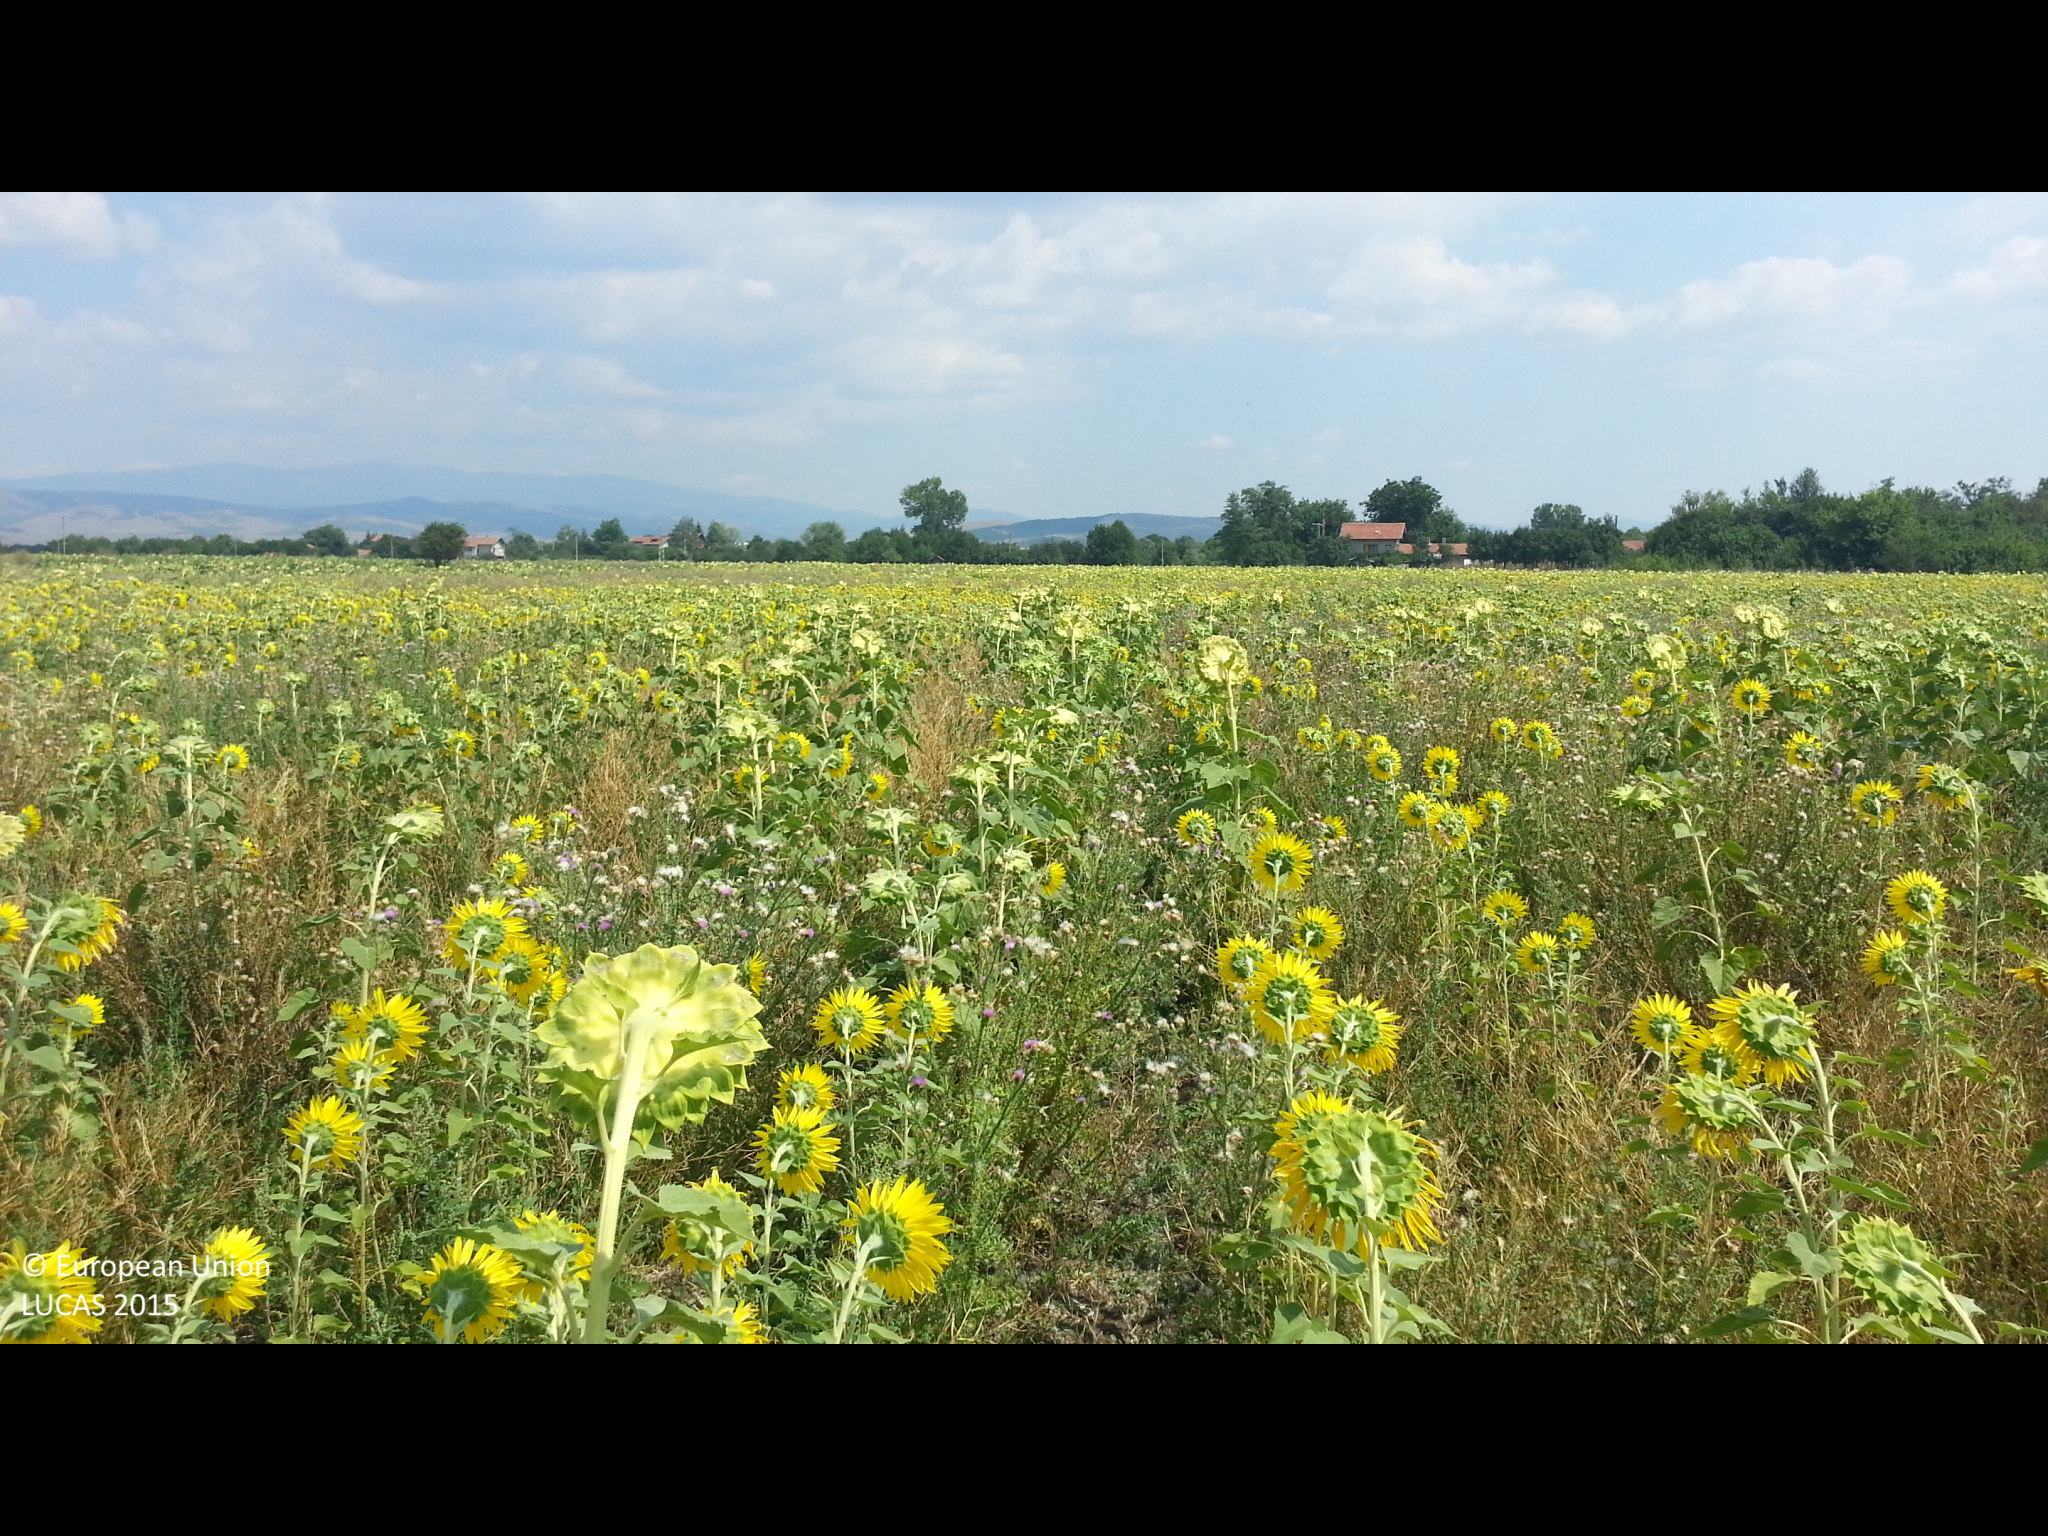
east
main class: Cropland
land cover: Sunflower
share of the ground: 50 - 75 %
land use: Agriculture (excluding fallow land and kitchen gardens)
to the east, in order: Sunflower
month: August
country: BG
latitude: 42.4755
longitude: 22.9571
